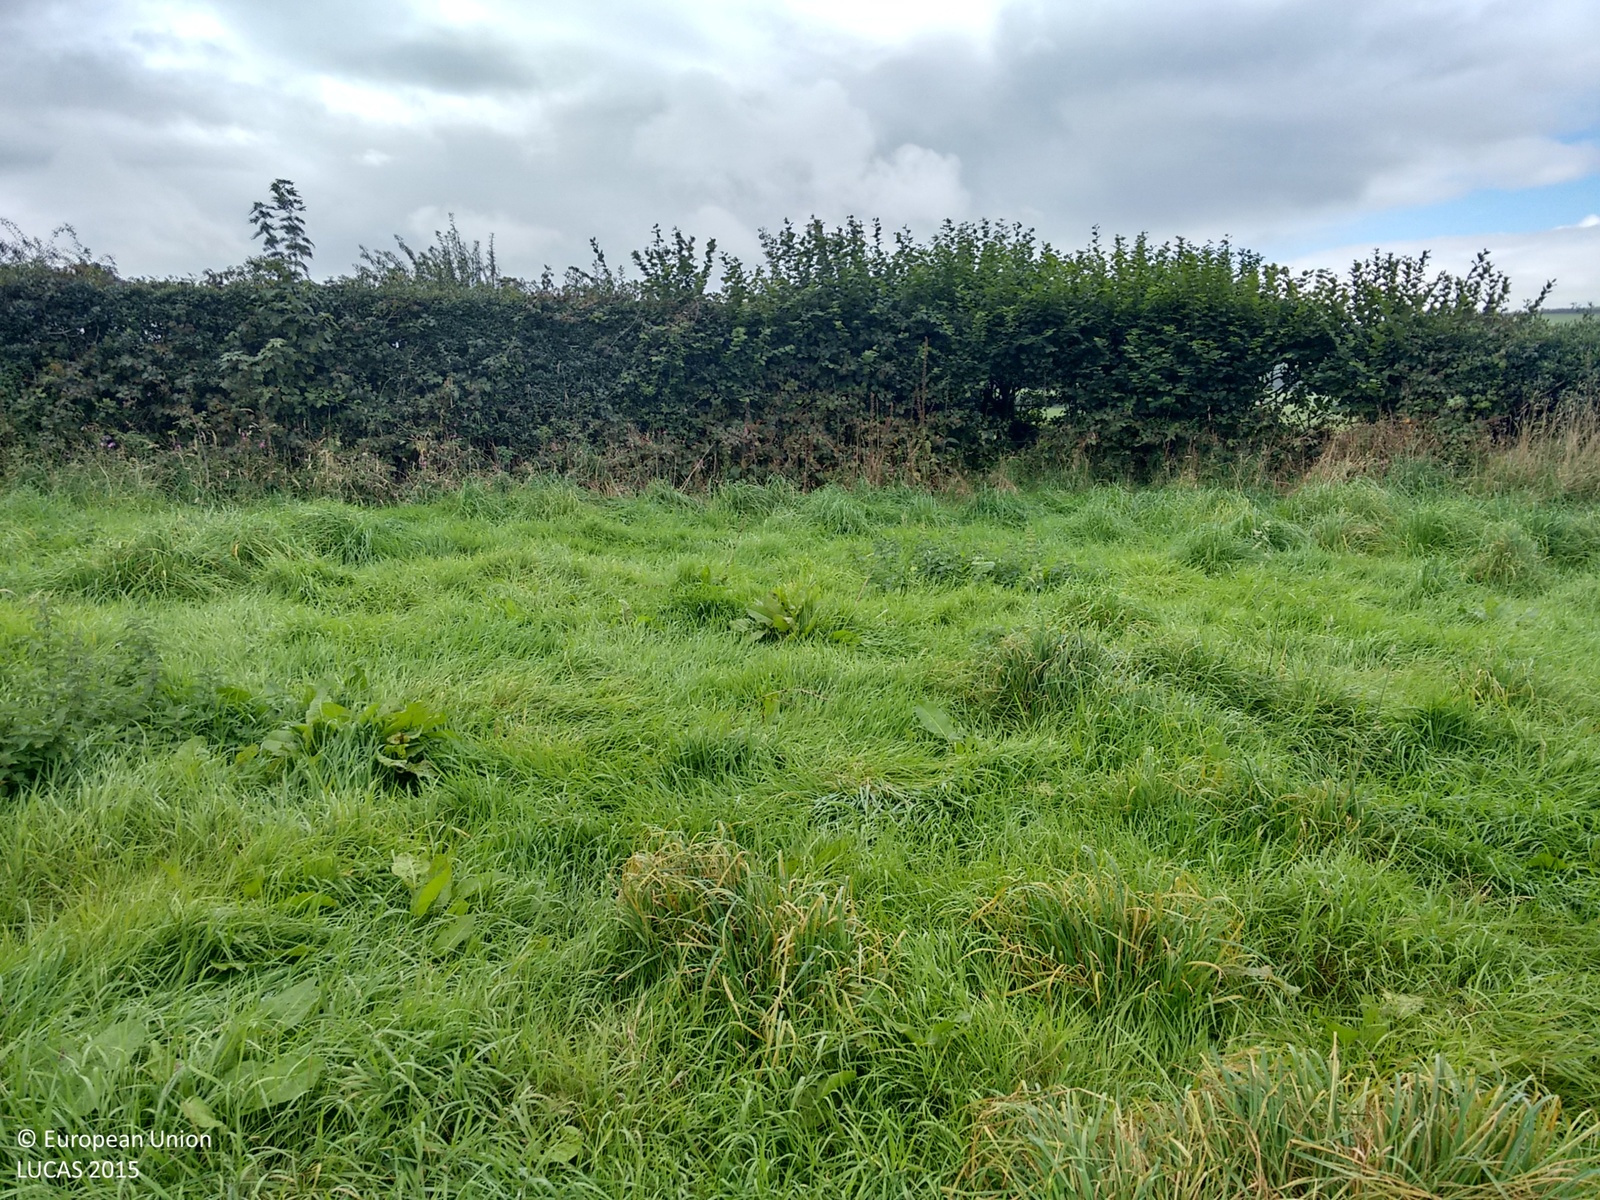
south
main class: Grassland
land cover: Grassland without tree/shrub cover
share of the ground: > 75 %
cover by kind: herbaceous plants 100 %
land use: Agriculture (excluding fallow land and kitchen gardens)
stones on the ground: < 10 %
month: September
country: GB
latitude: 50.6029
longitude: -4.2133
